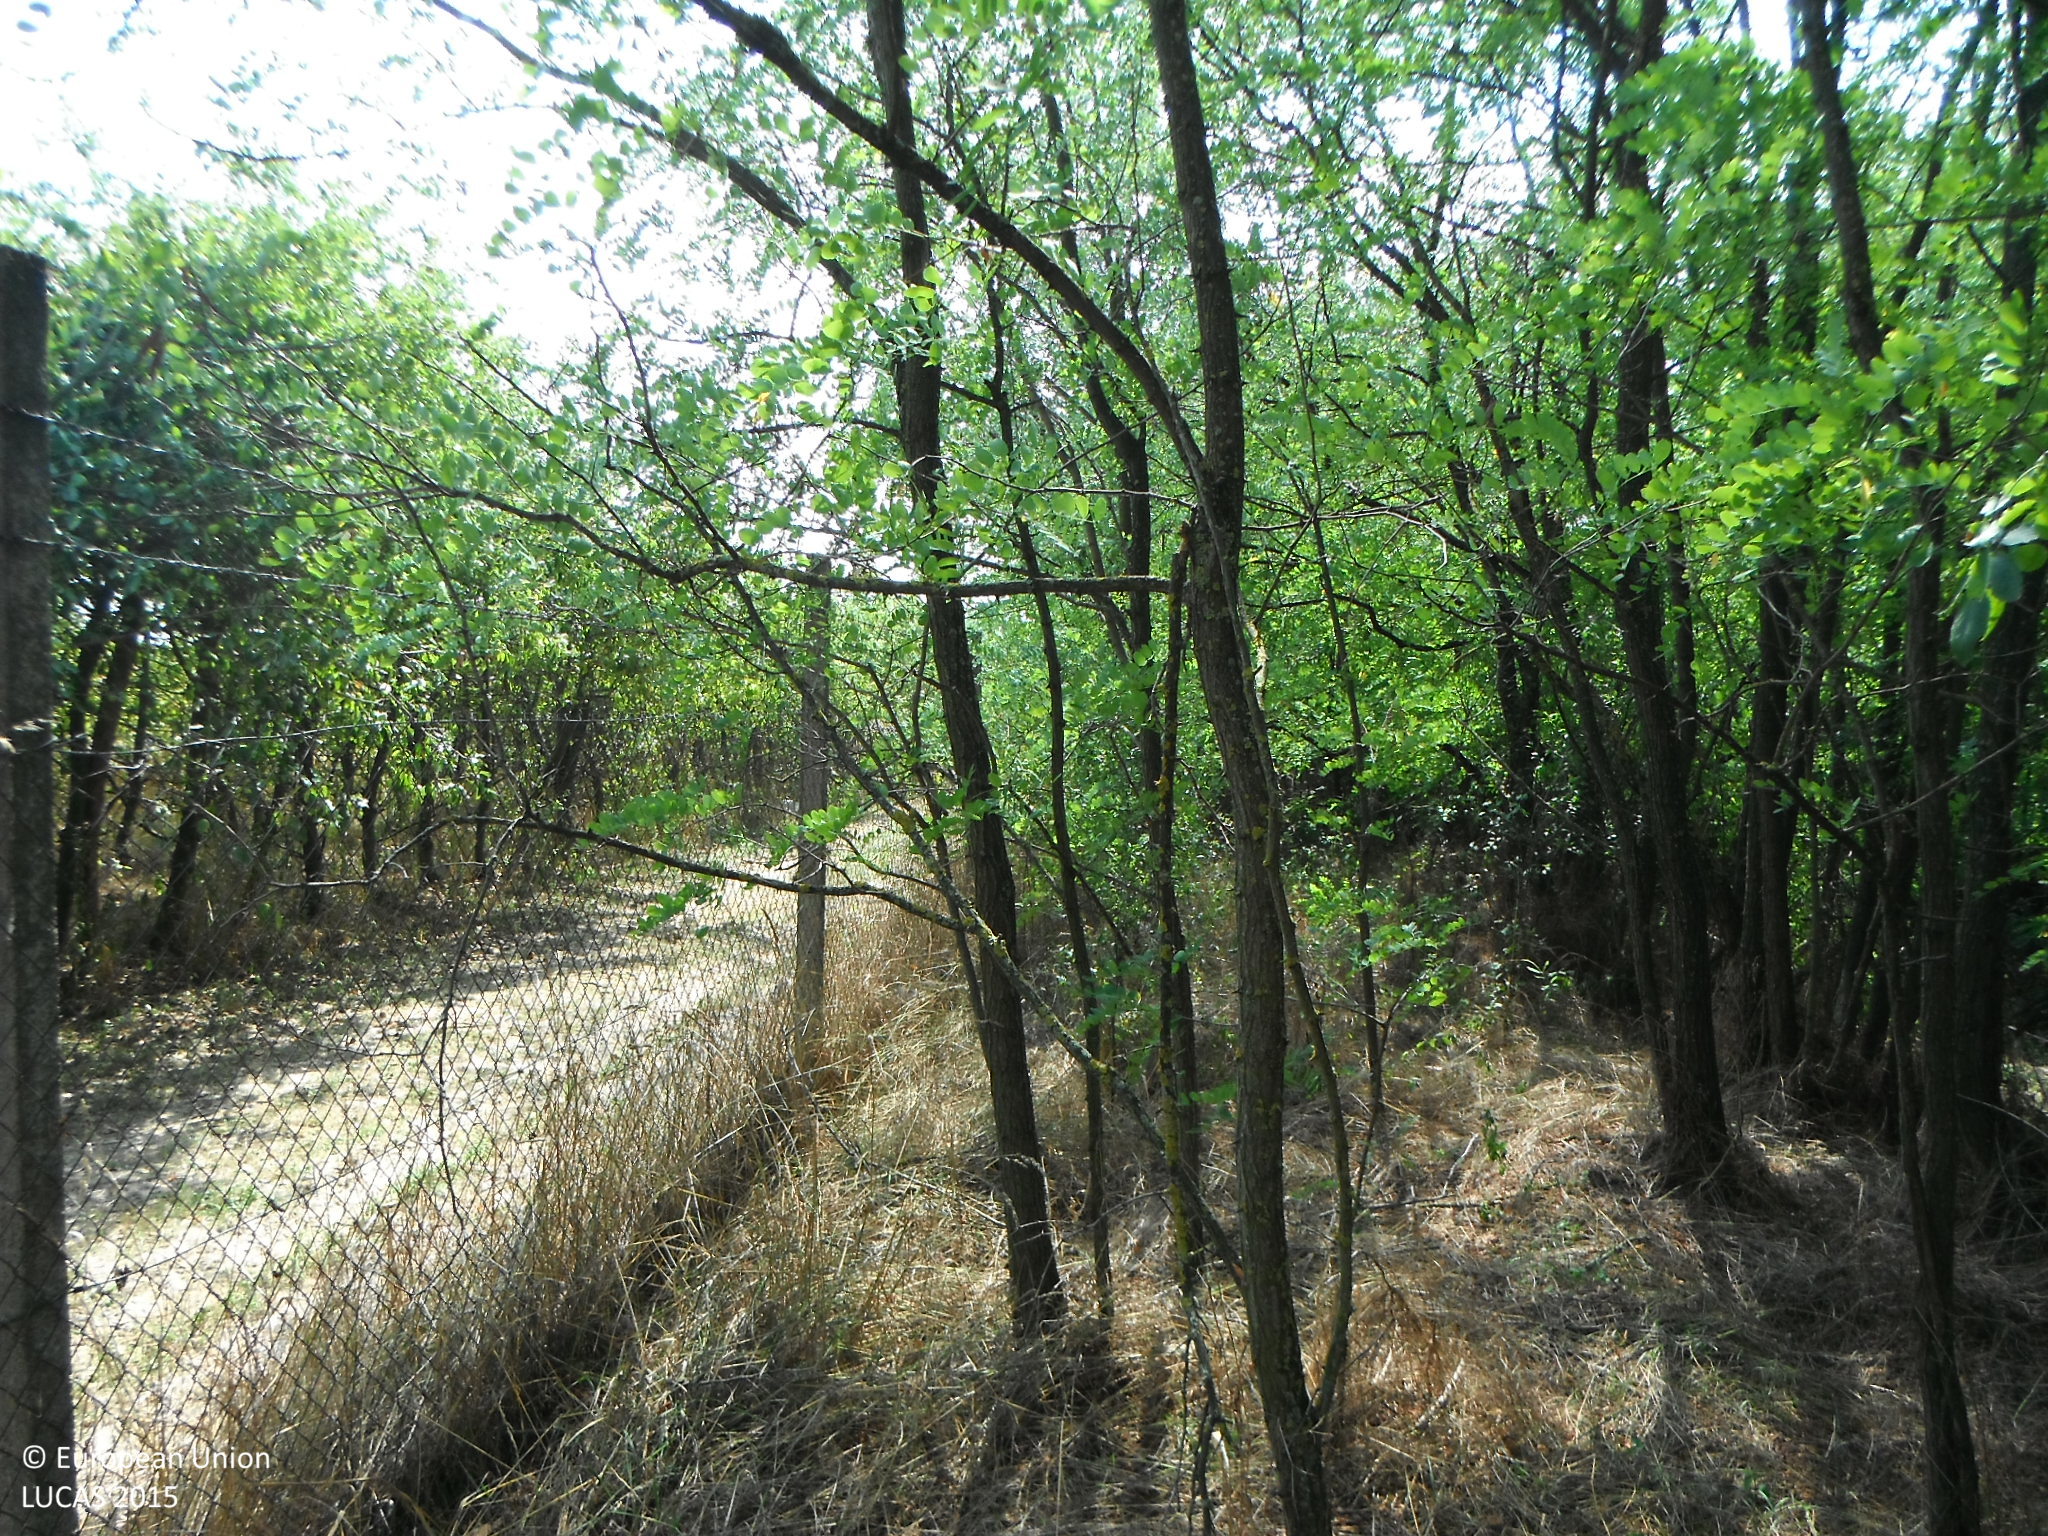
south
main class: Cropland
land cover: Apple fruit
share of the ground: > 75 %
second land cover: Grassland without tree/shrub cover
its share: > 75 %
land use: Agriculture (excluding fallow land and kitchen gardens)
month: September
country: SK
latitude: 48.4386
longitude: 21.6604
